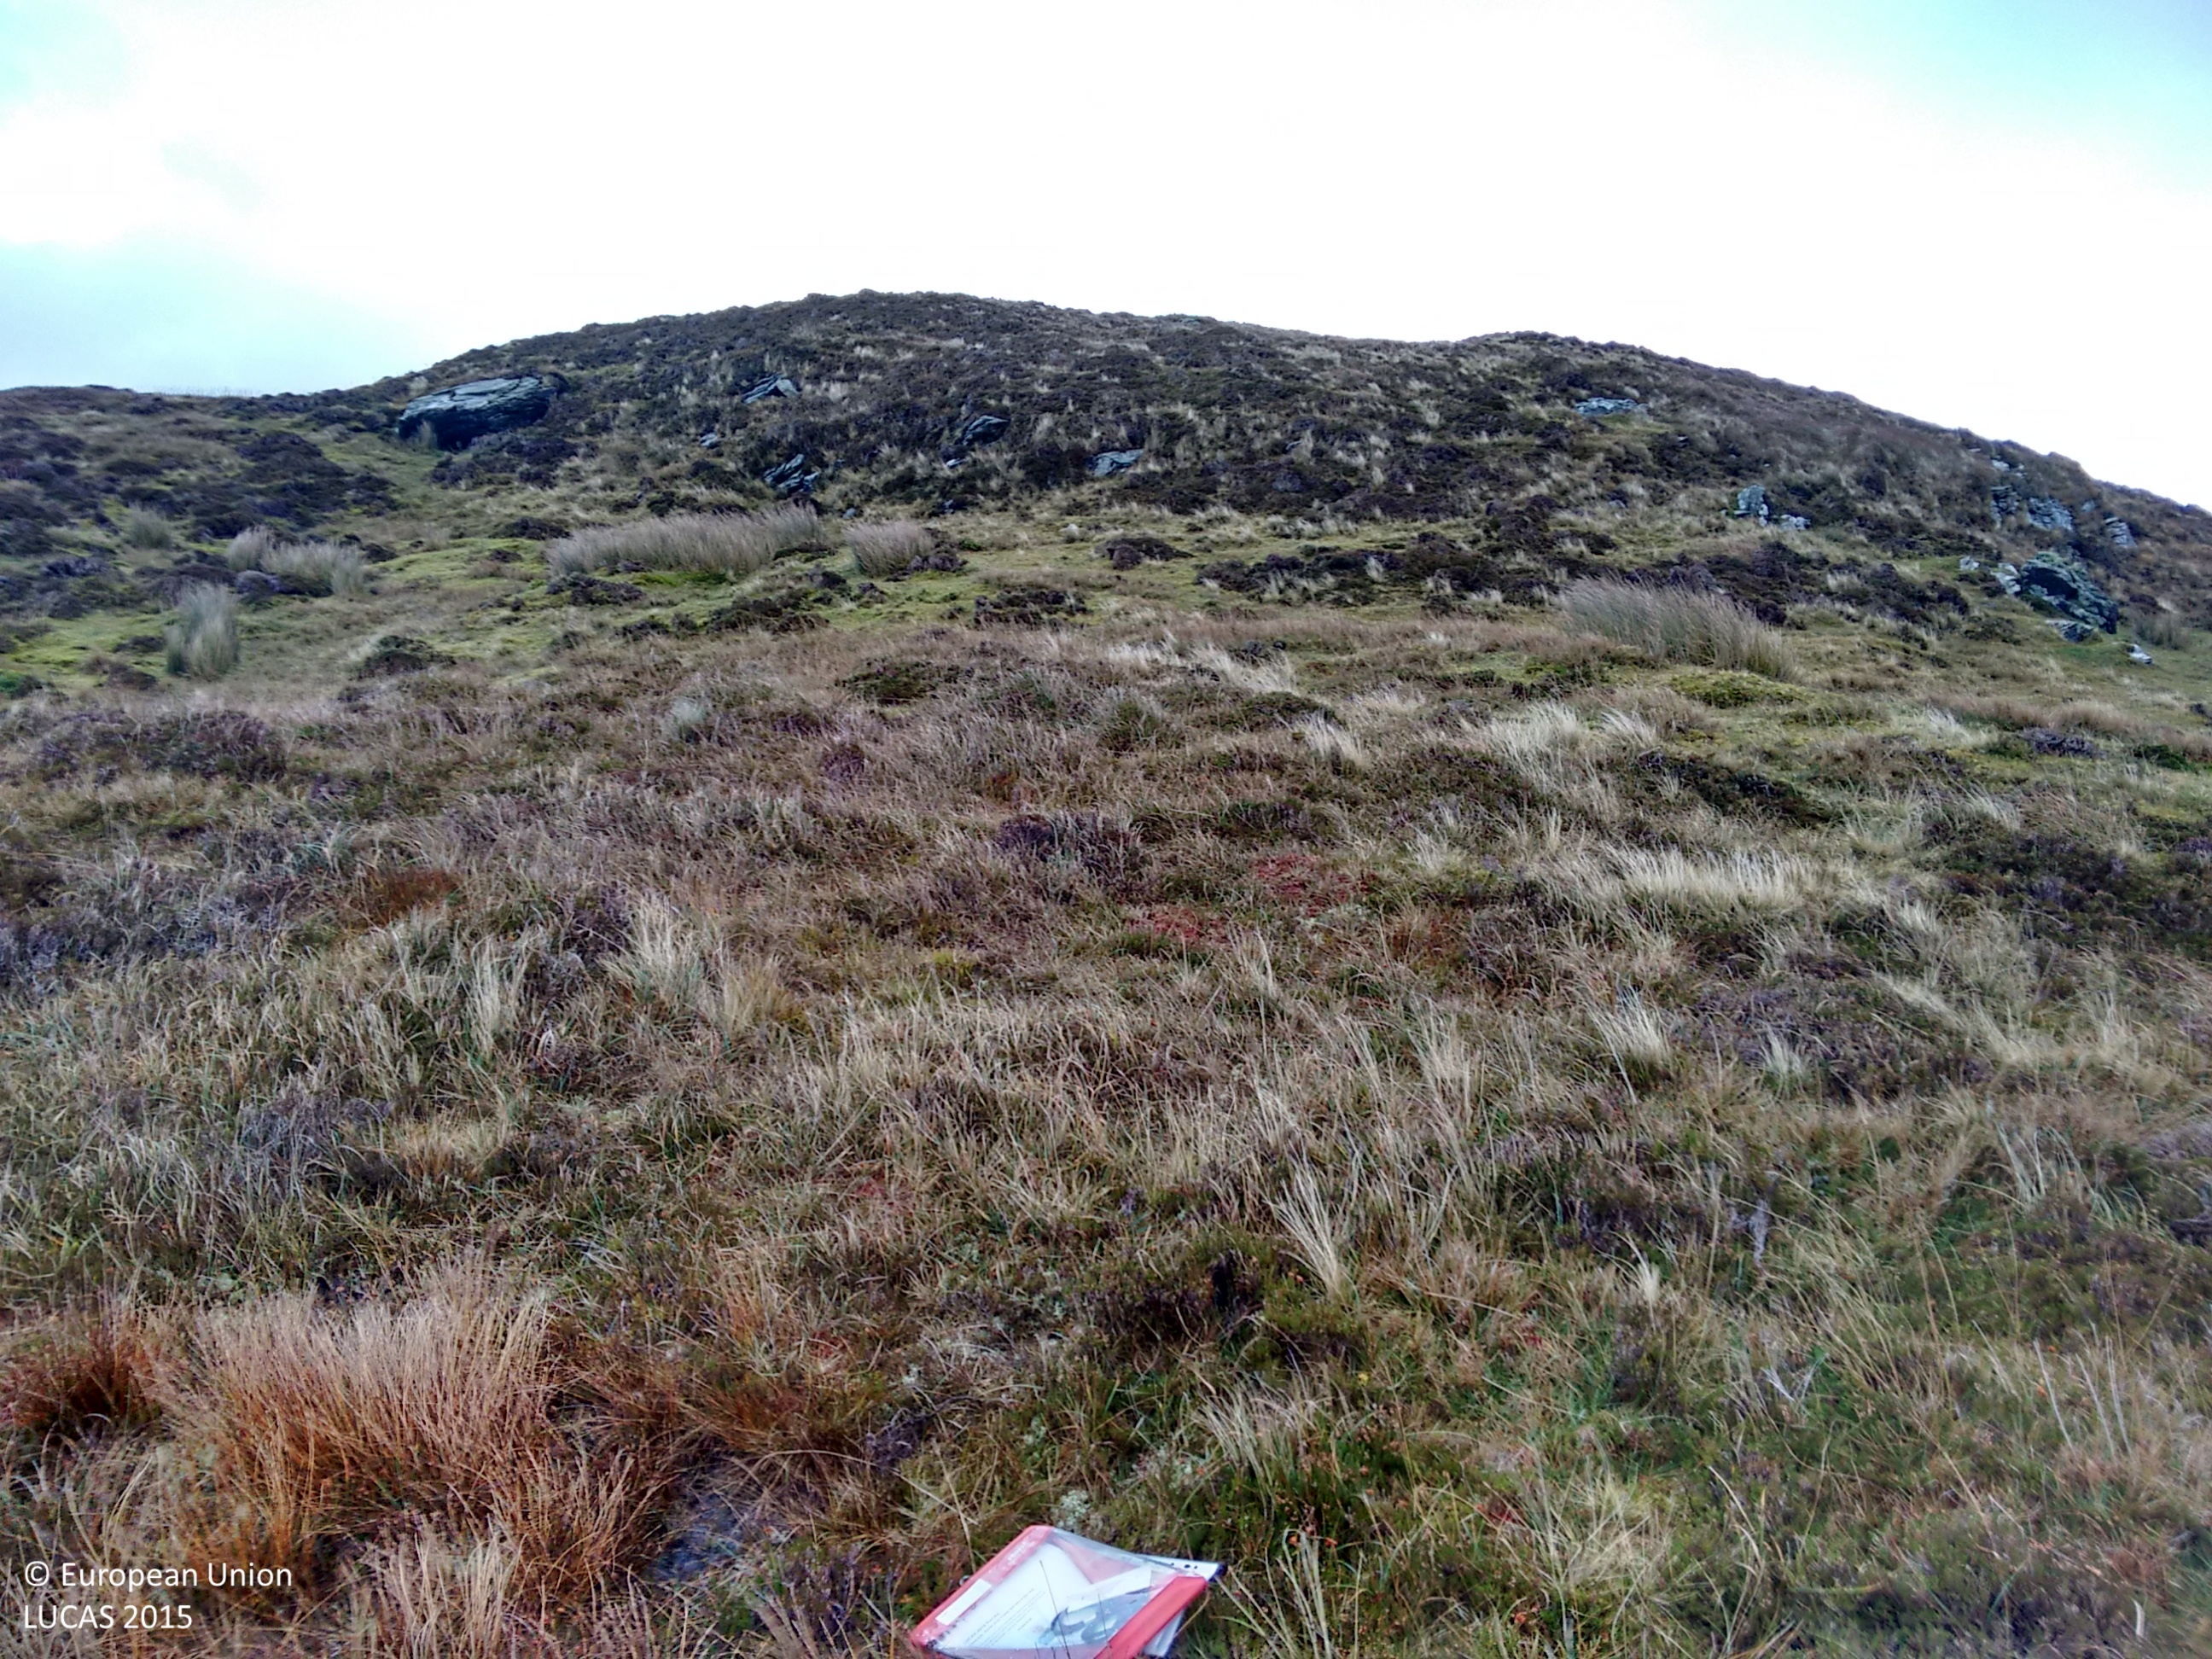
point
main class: Shrubland
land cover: Shrubland without tree cover
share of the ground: > 75 %
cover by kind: shrubs 40 %, herbaceous plants 40 %, lichens and mosses 20 %
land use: Agriculture (excluding fallow land and kitchen gardens)
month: November
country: IE
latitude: 54.6990
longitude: -8.7102
